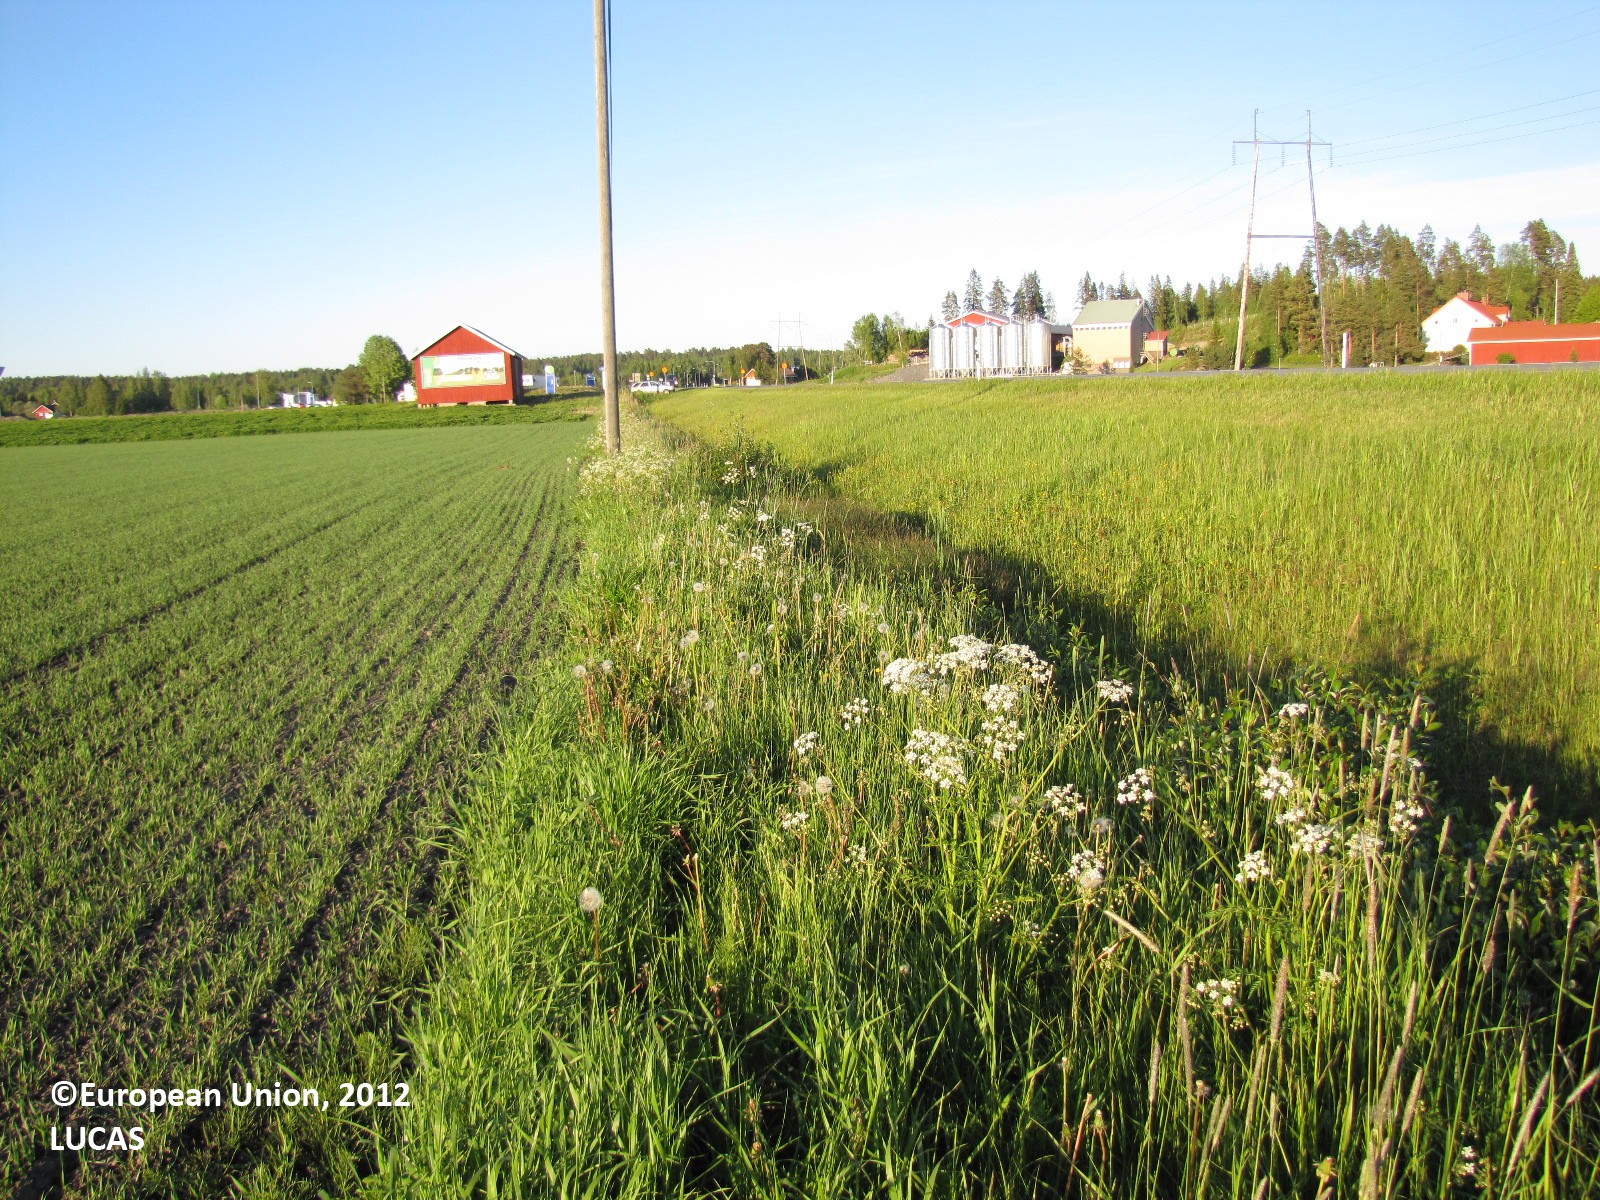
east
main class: Cropland
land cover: Common wheat
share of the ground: 25 - 50 %
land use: Agriculture (excluding fallow land and kitchen gardens)
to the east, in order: Common wheat; Clovers
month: June
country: FI
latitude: 61.3220
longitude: 22.9041
